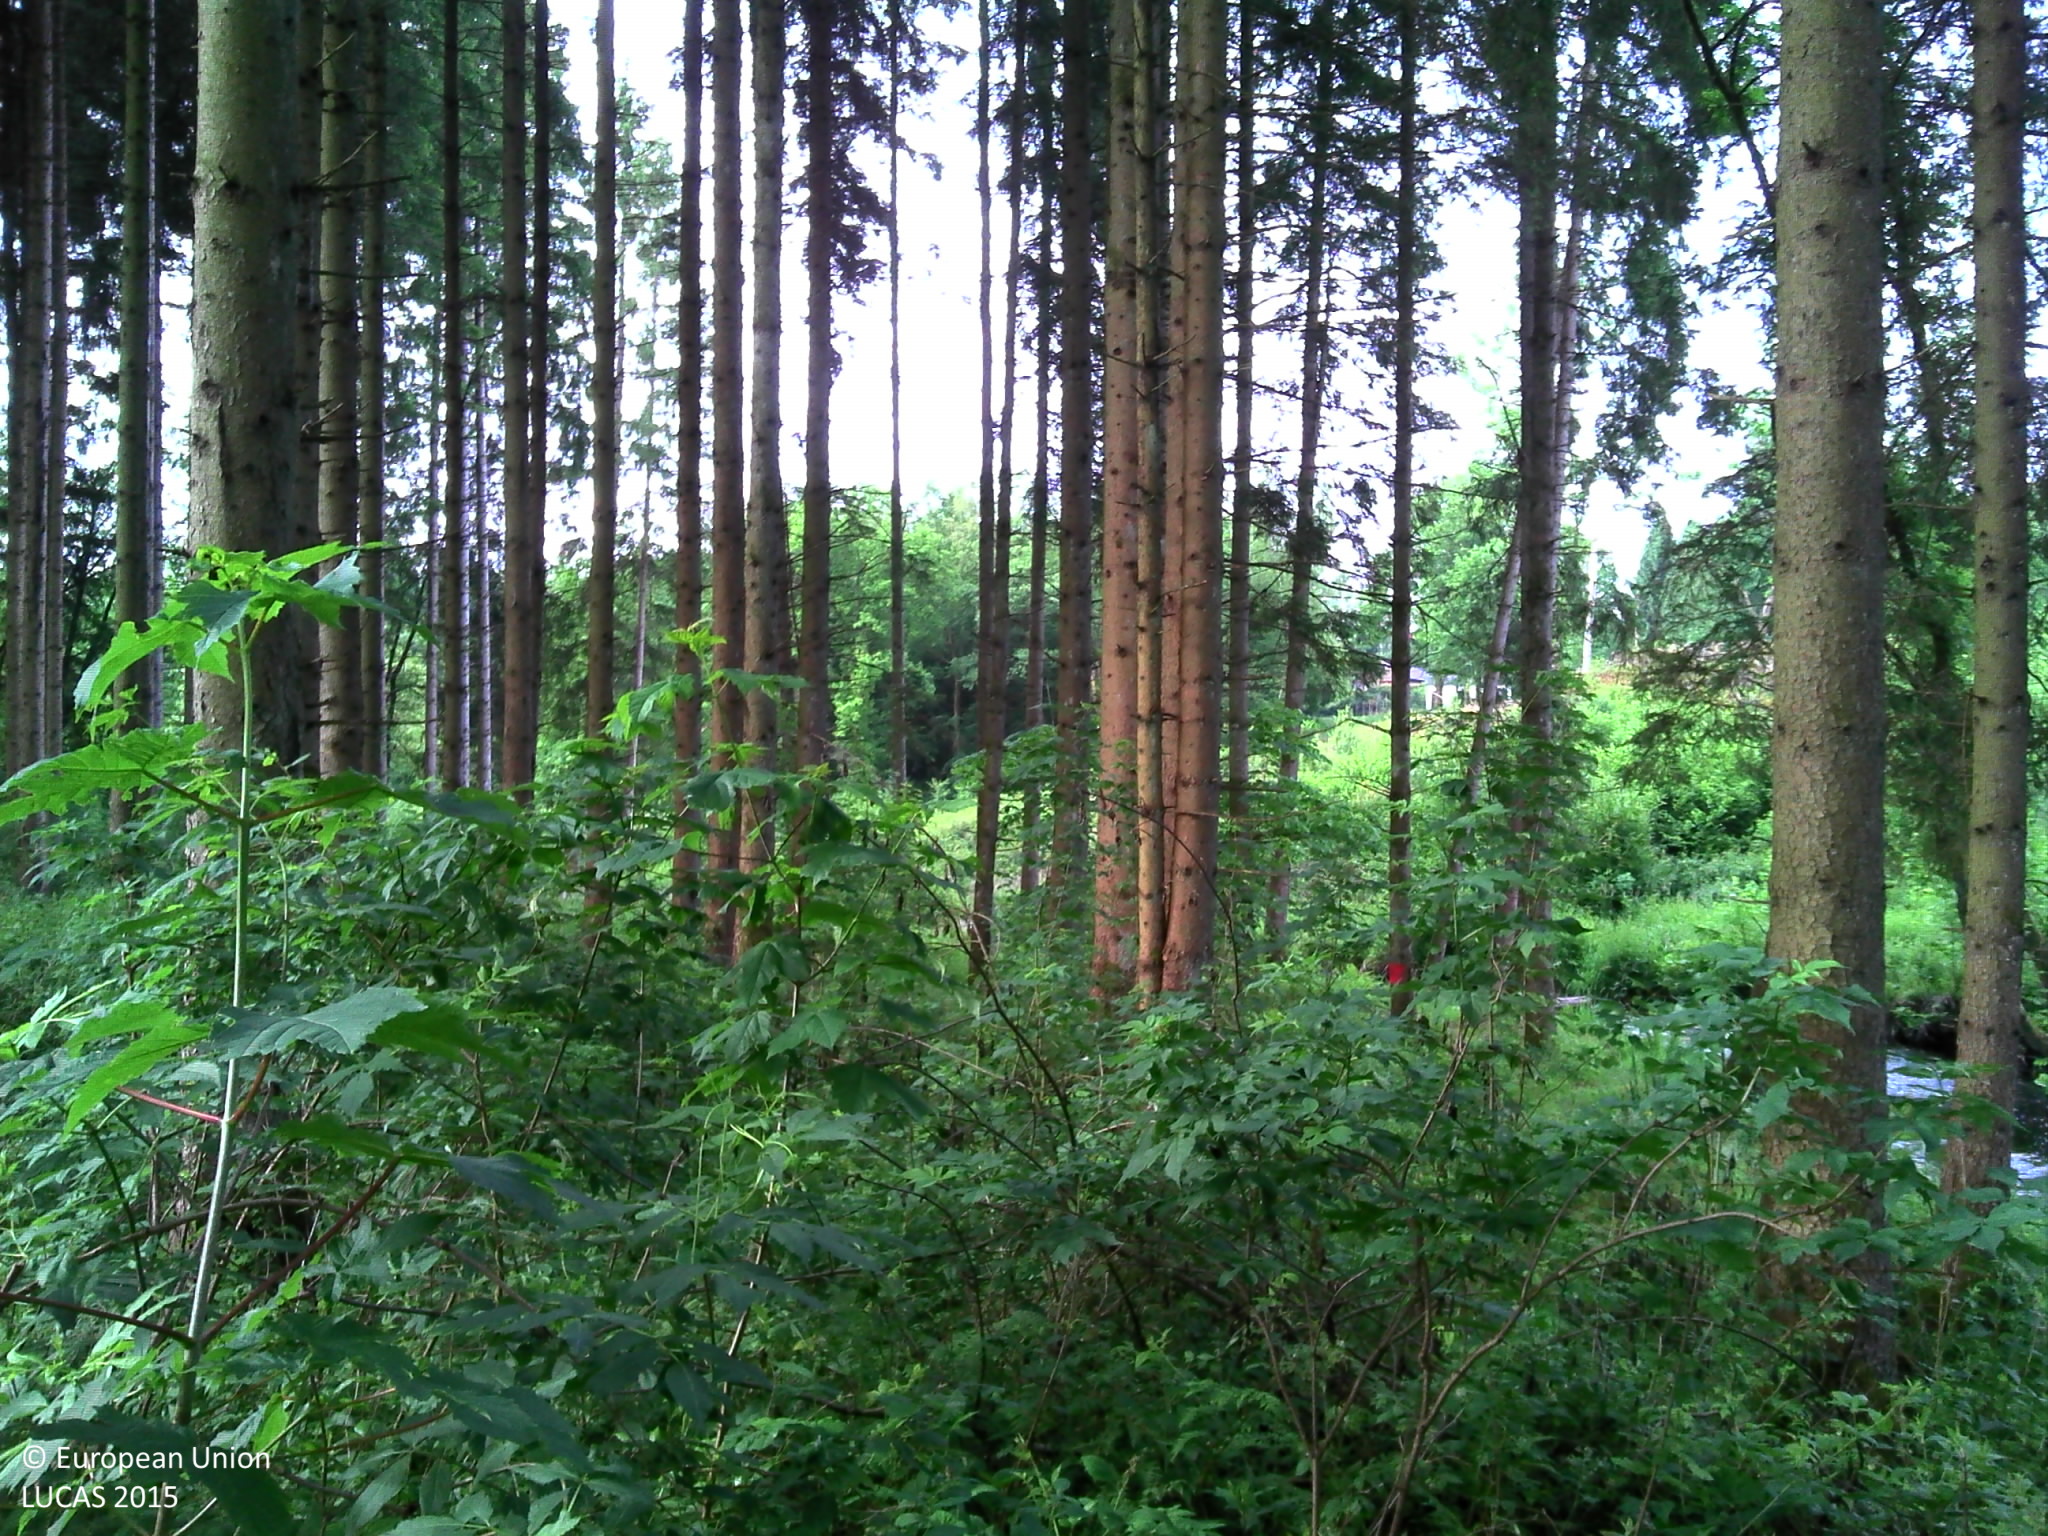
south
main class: Woodland
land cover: Spruce dominated coniferous woodland
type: alpine coniferous forest
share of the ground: > 75 %
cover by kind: coniferous forest trees 95 %, herbaceous plants 5 %
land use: Forestry
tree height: > 5 m
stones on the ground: < 10 %
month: June
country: BE
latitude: 49.9746
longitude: 5.1871
